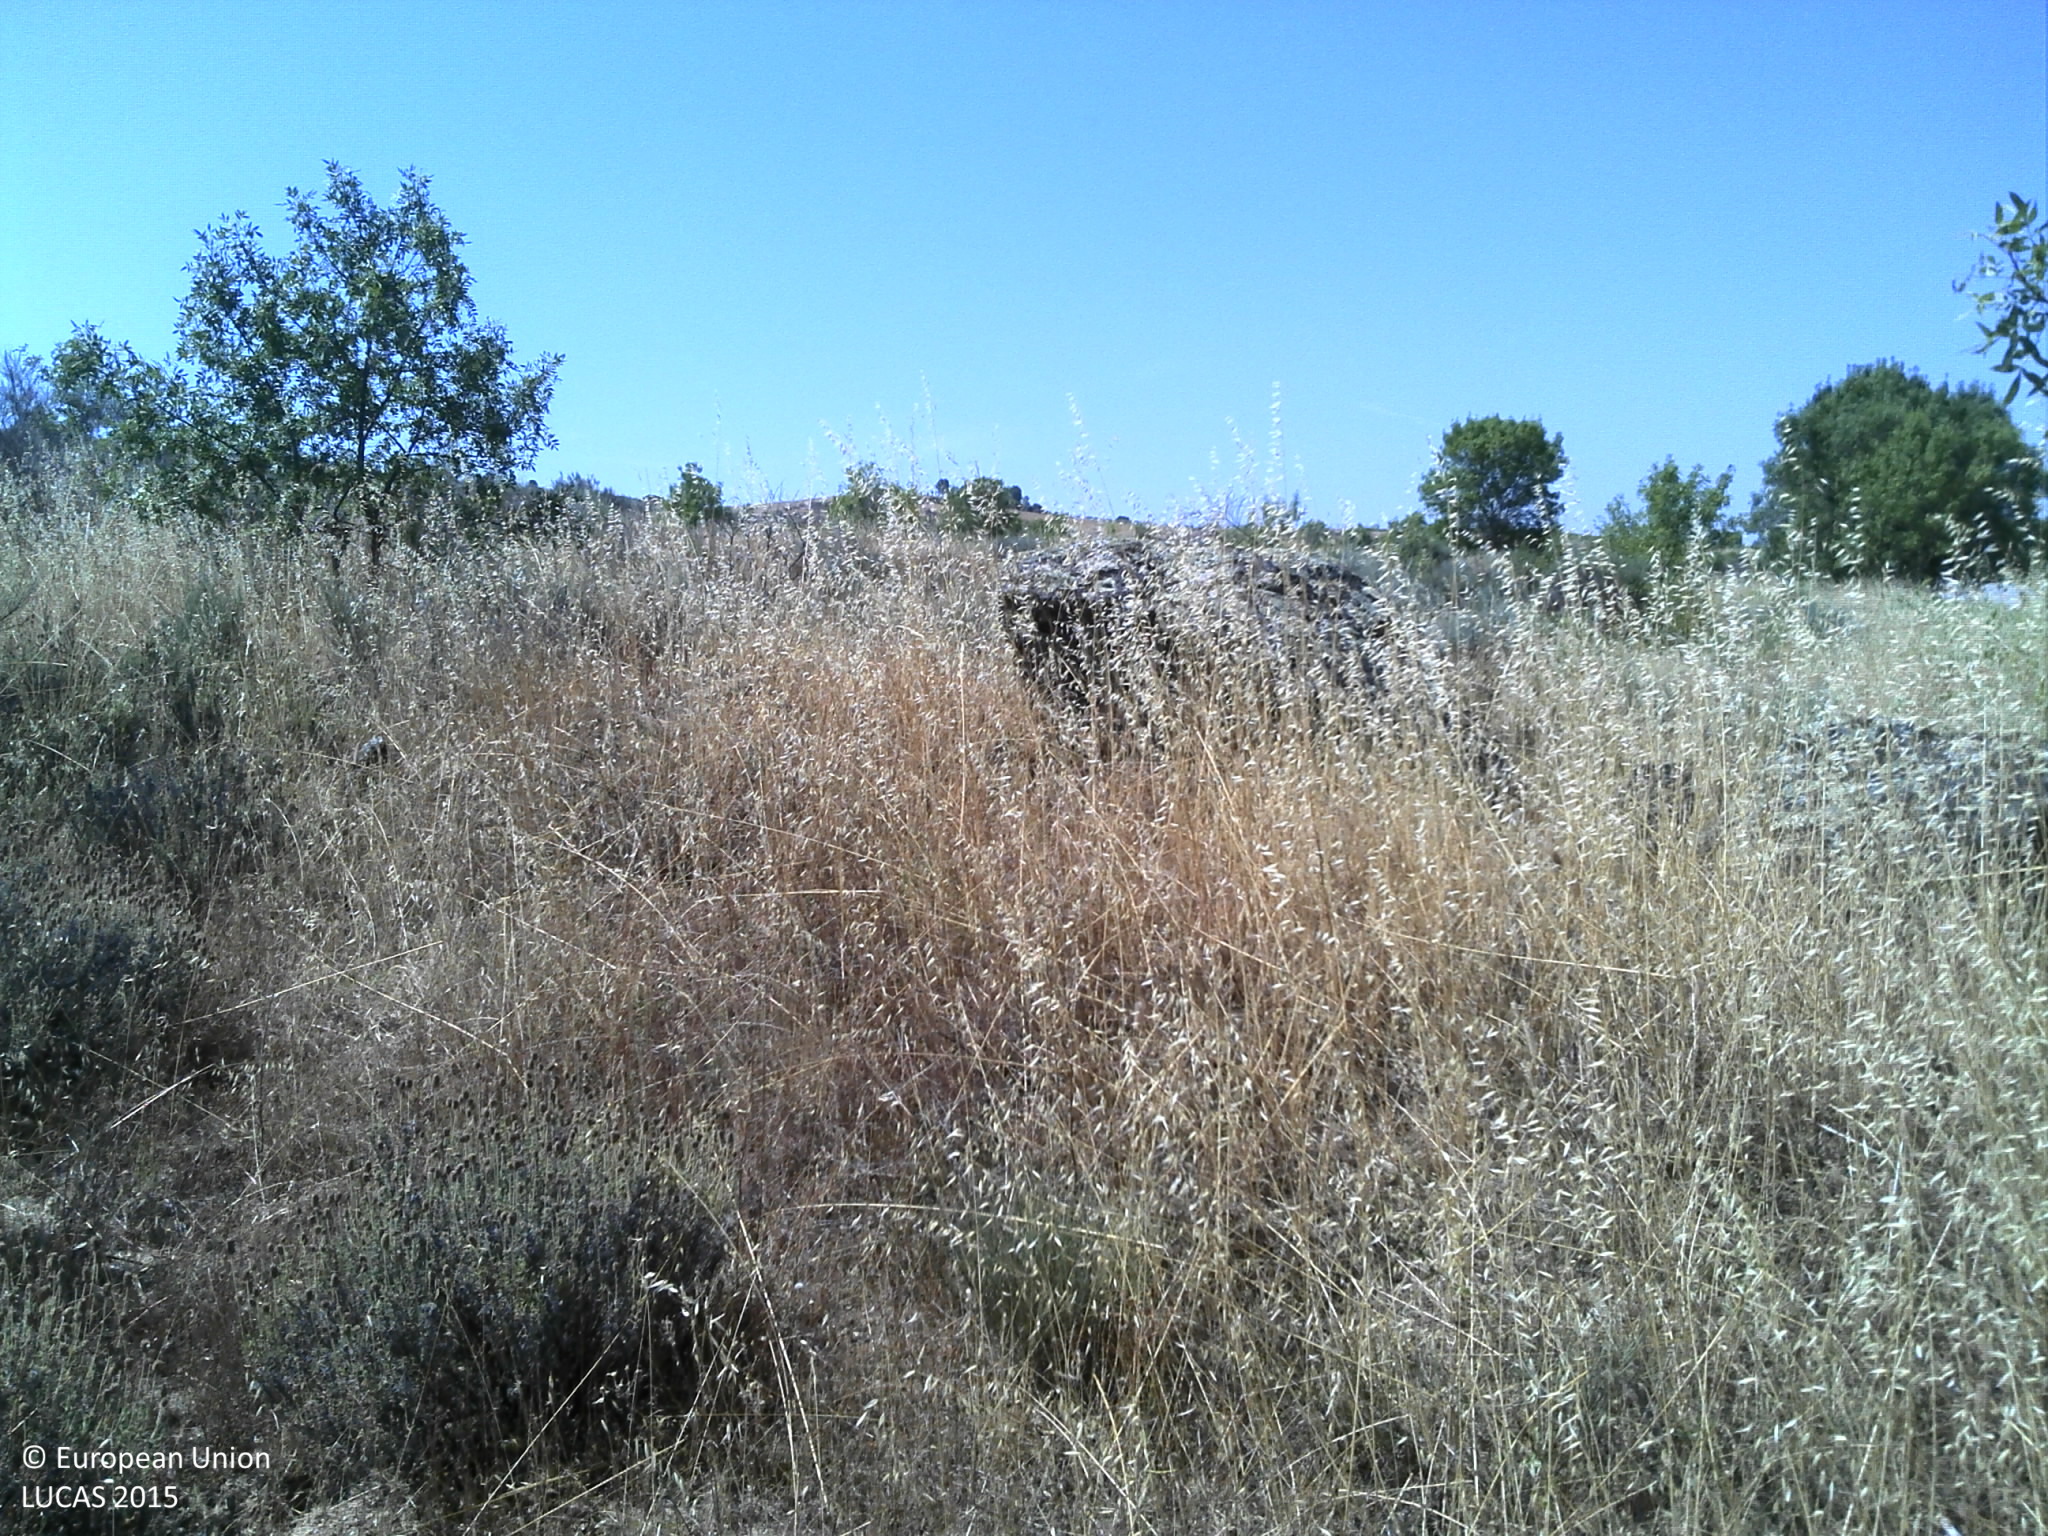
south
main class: Shrubland
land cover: Shrubland with sparse tree cover
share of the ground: > 75 %
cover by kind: shrubs 95 %, broadleaved forest trees 5 %
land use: Semi-natural and natural areas not in use
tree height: < 5 m
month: July
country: PT
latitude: 40.9300
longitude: -7.2001
